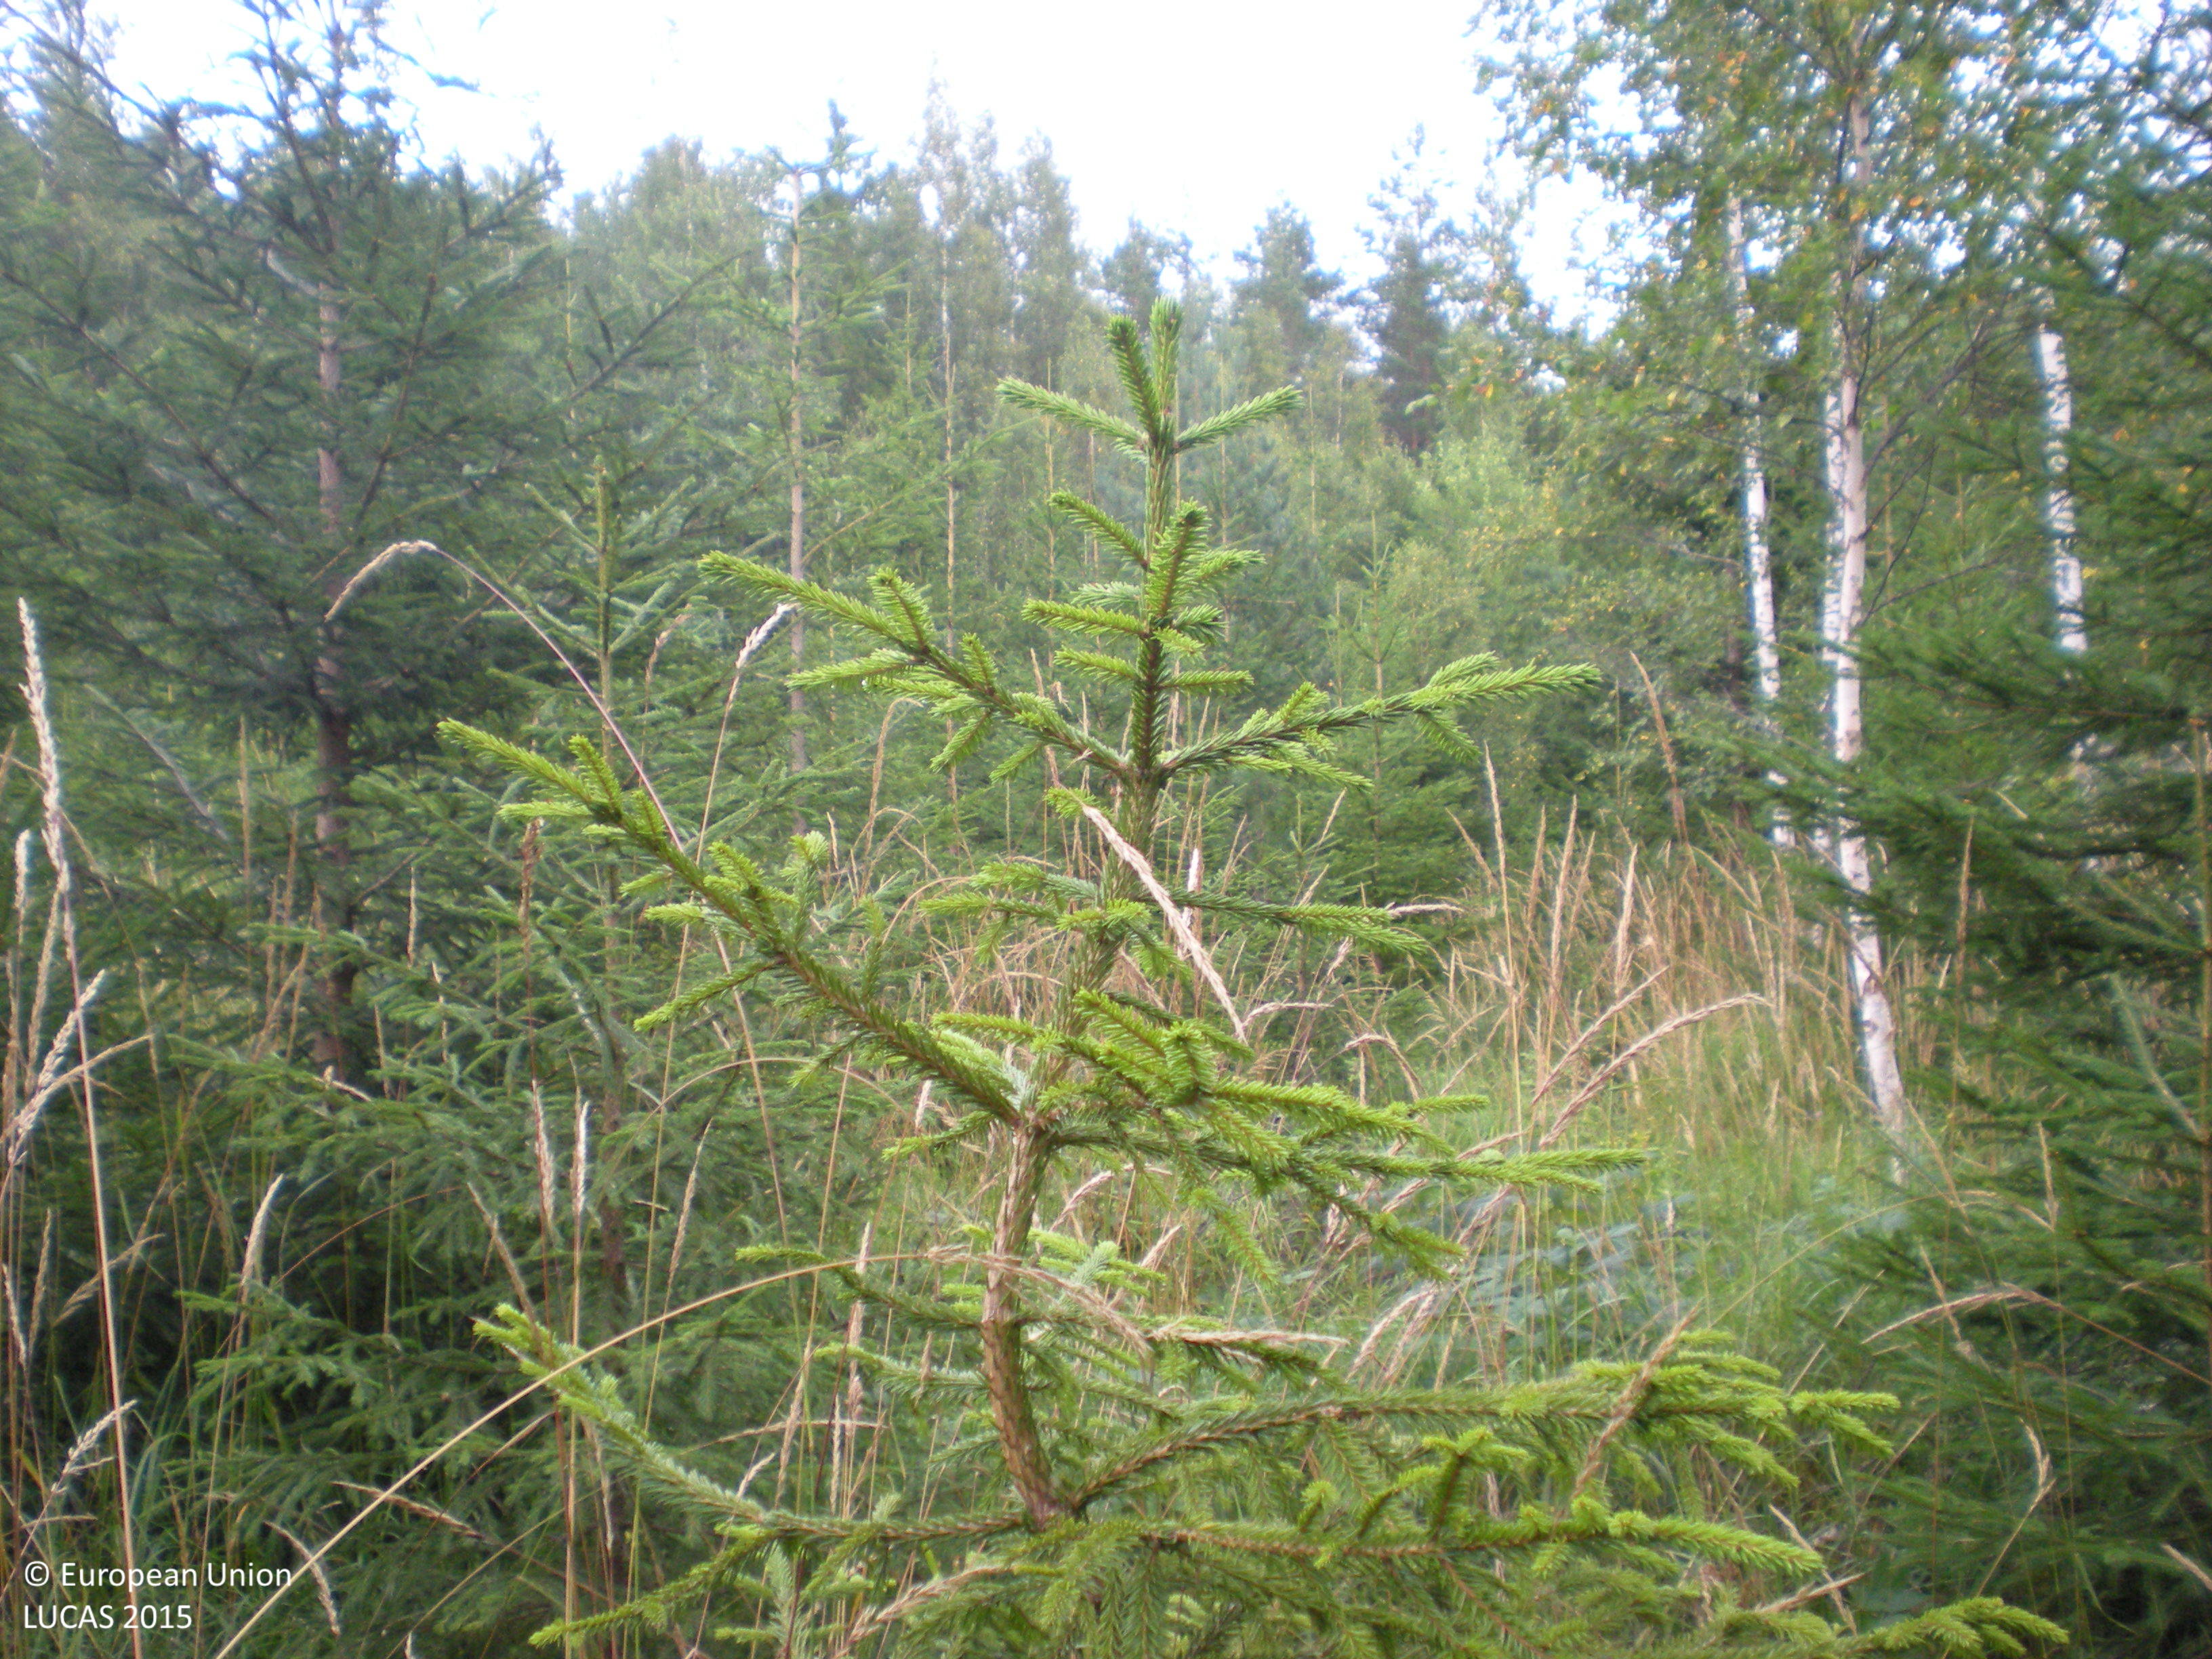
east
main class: Woodland
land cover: Spruce dominated mixed woodland
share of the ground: 50 - 75 %
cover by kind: coniferous forest trees 55 %, herbaceous plants 25 %, broadleaved forest trees 20 %
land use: Forestry
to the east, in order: Spruce dominated mixed woodland; Pine dominated coniferous woodland; Spruce dominated mixed woodland; Pine dominated coniferous woodland
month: August
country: SE
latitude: 60.5256
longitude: 17.1136
